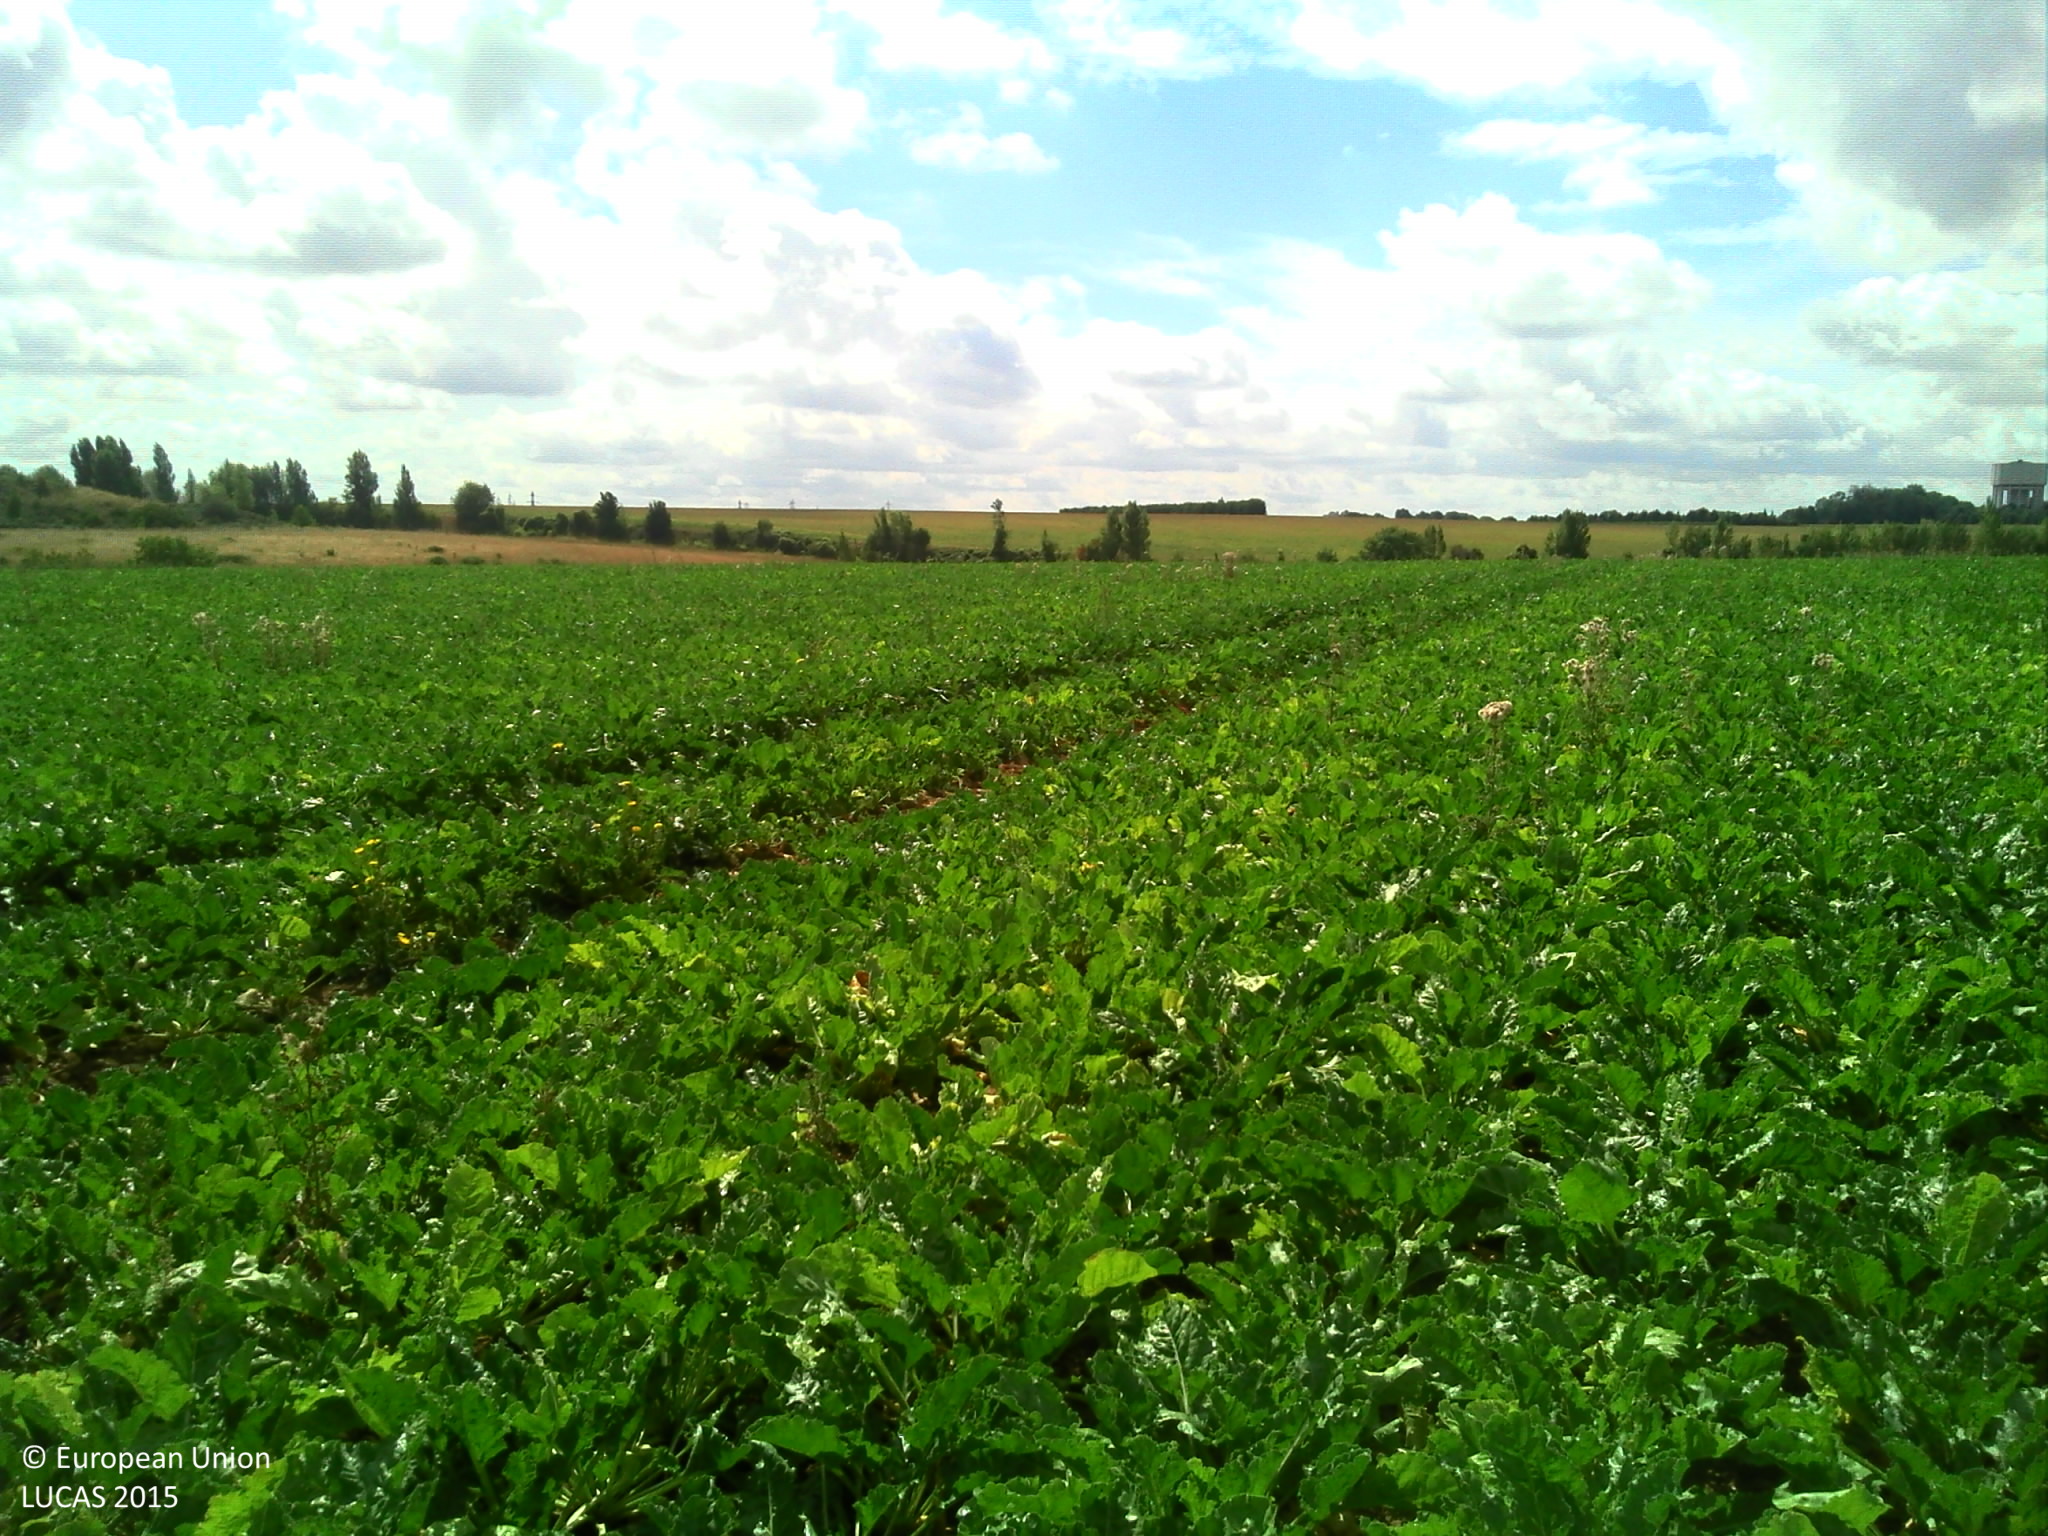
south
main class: Cropland
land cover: Sugar beet
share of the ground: > 75 %
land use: Agriculture (excluding fallow land and kitchen gardens)
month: August
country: FR
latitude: 49.0270
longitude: 2.3976
